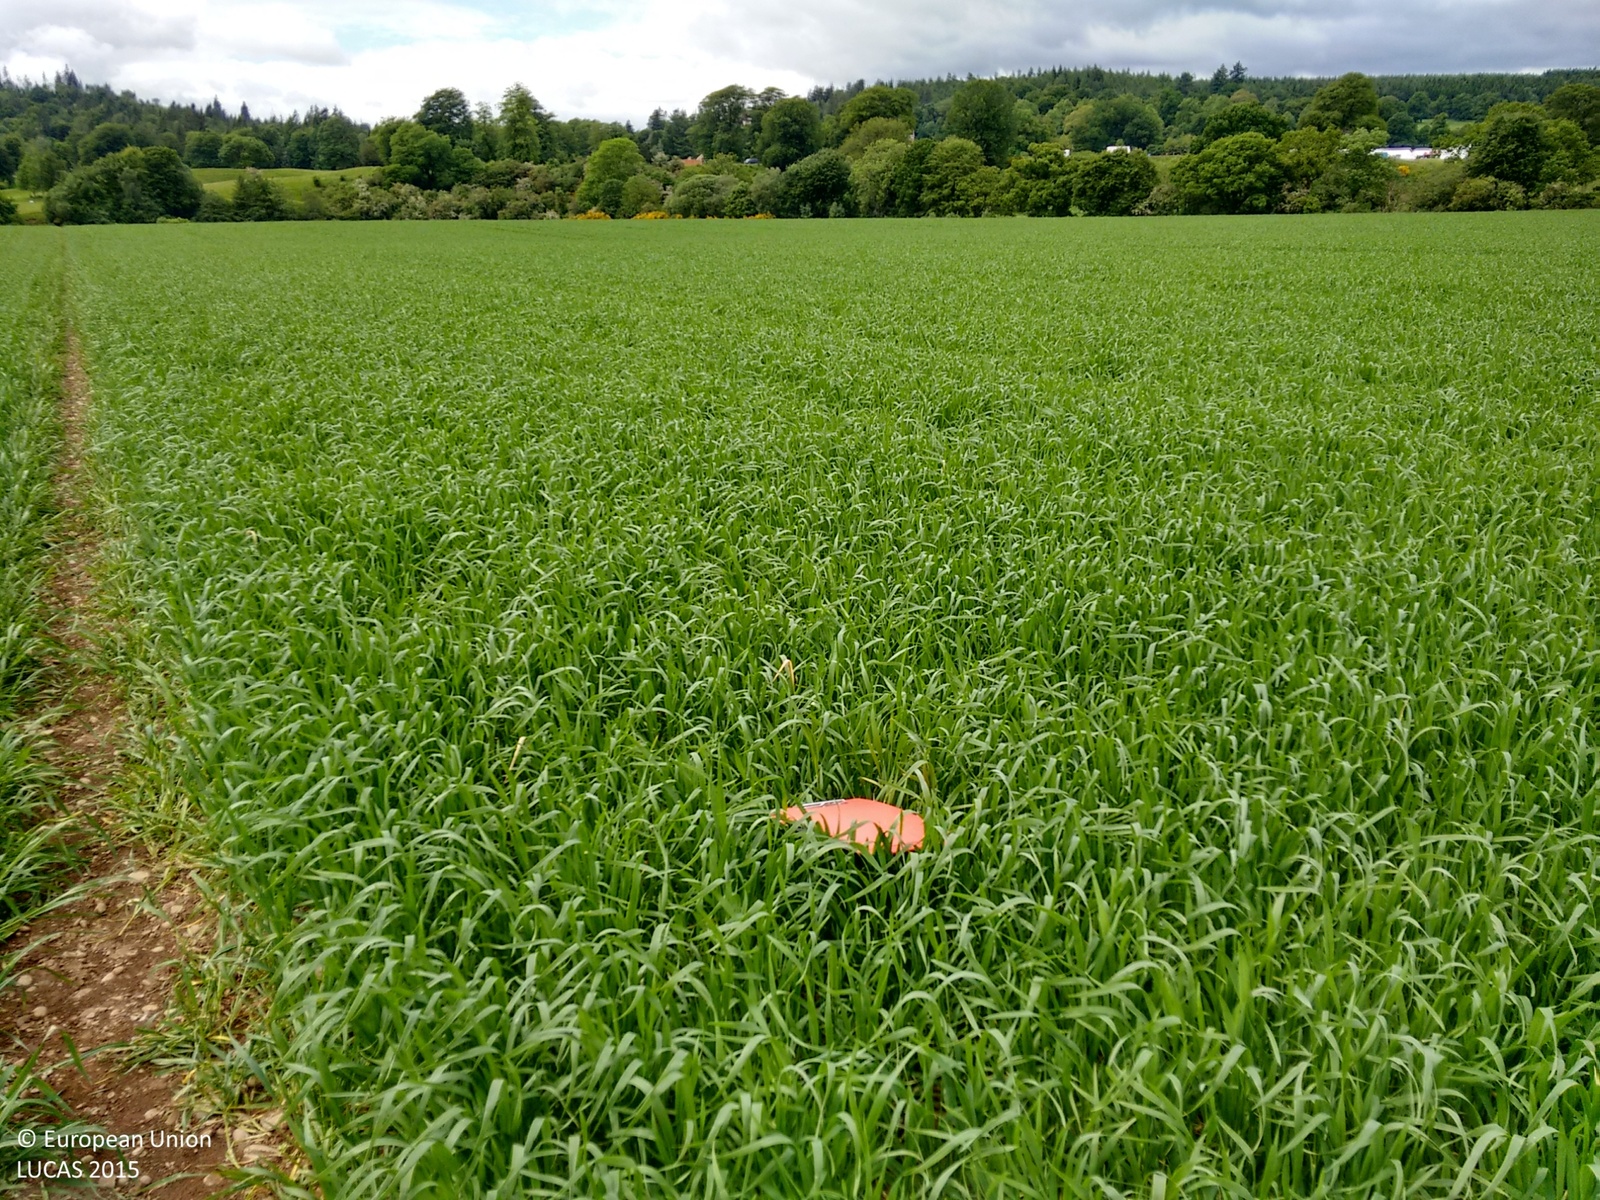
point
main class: Cropland
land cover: Barley
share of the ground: > 75 %
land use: Agriculture (excluding fallow land and kitchen gardens)
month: June
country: GB
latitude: 55.2733
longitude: -3.7955
